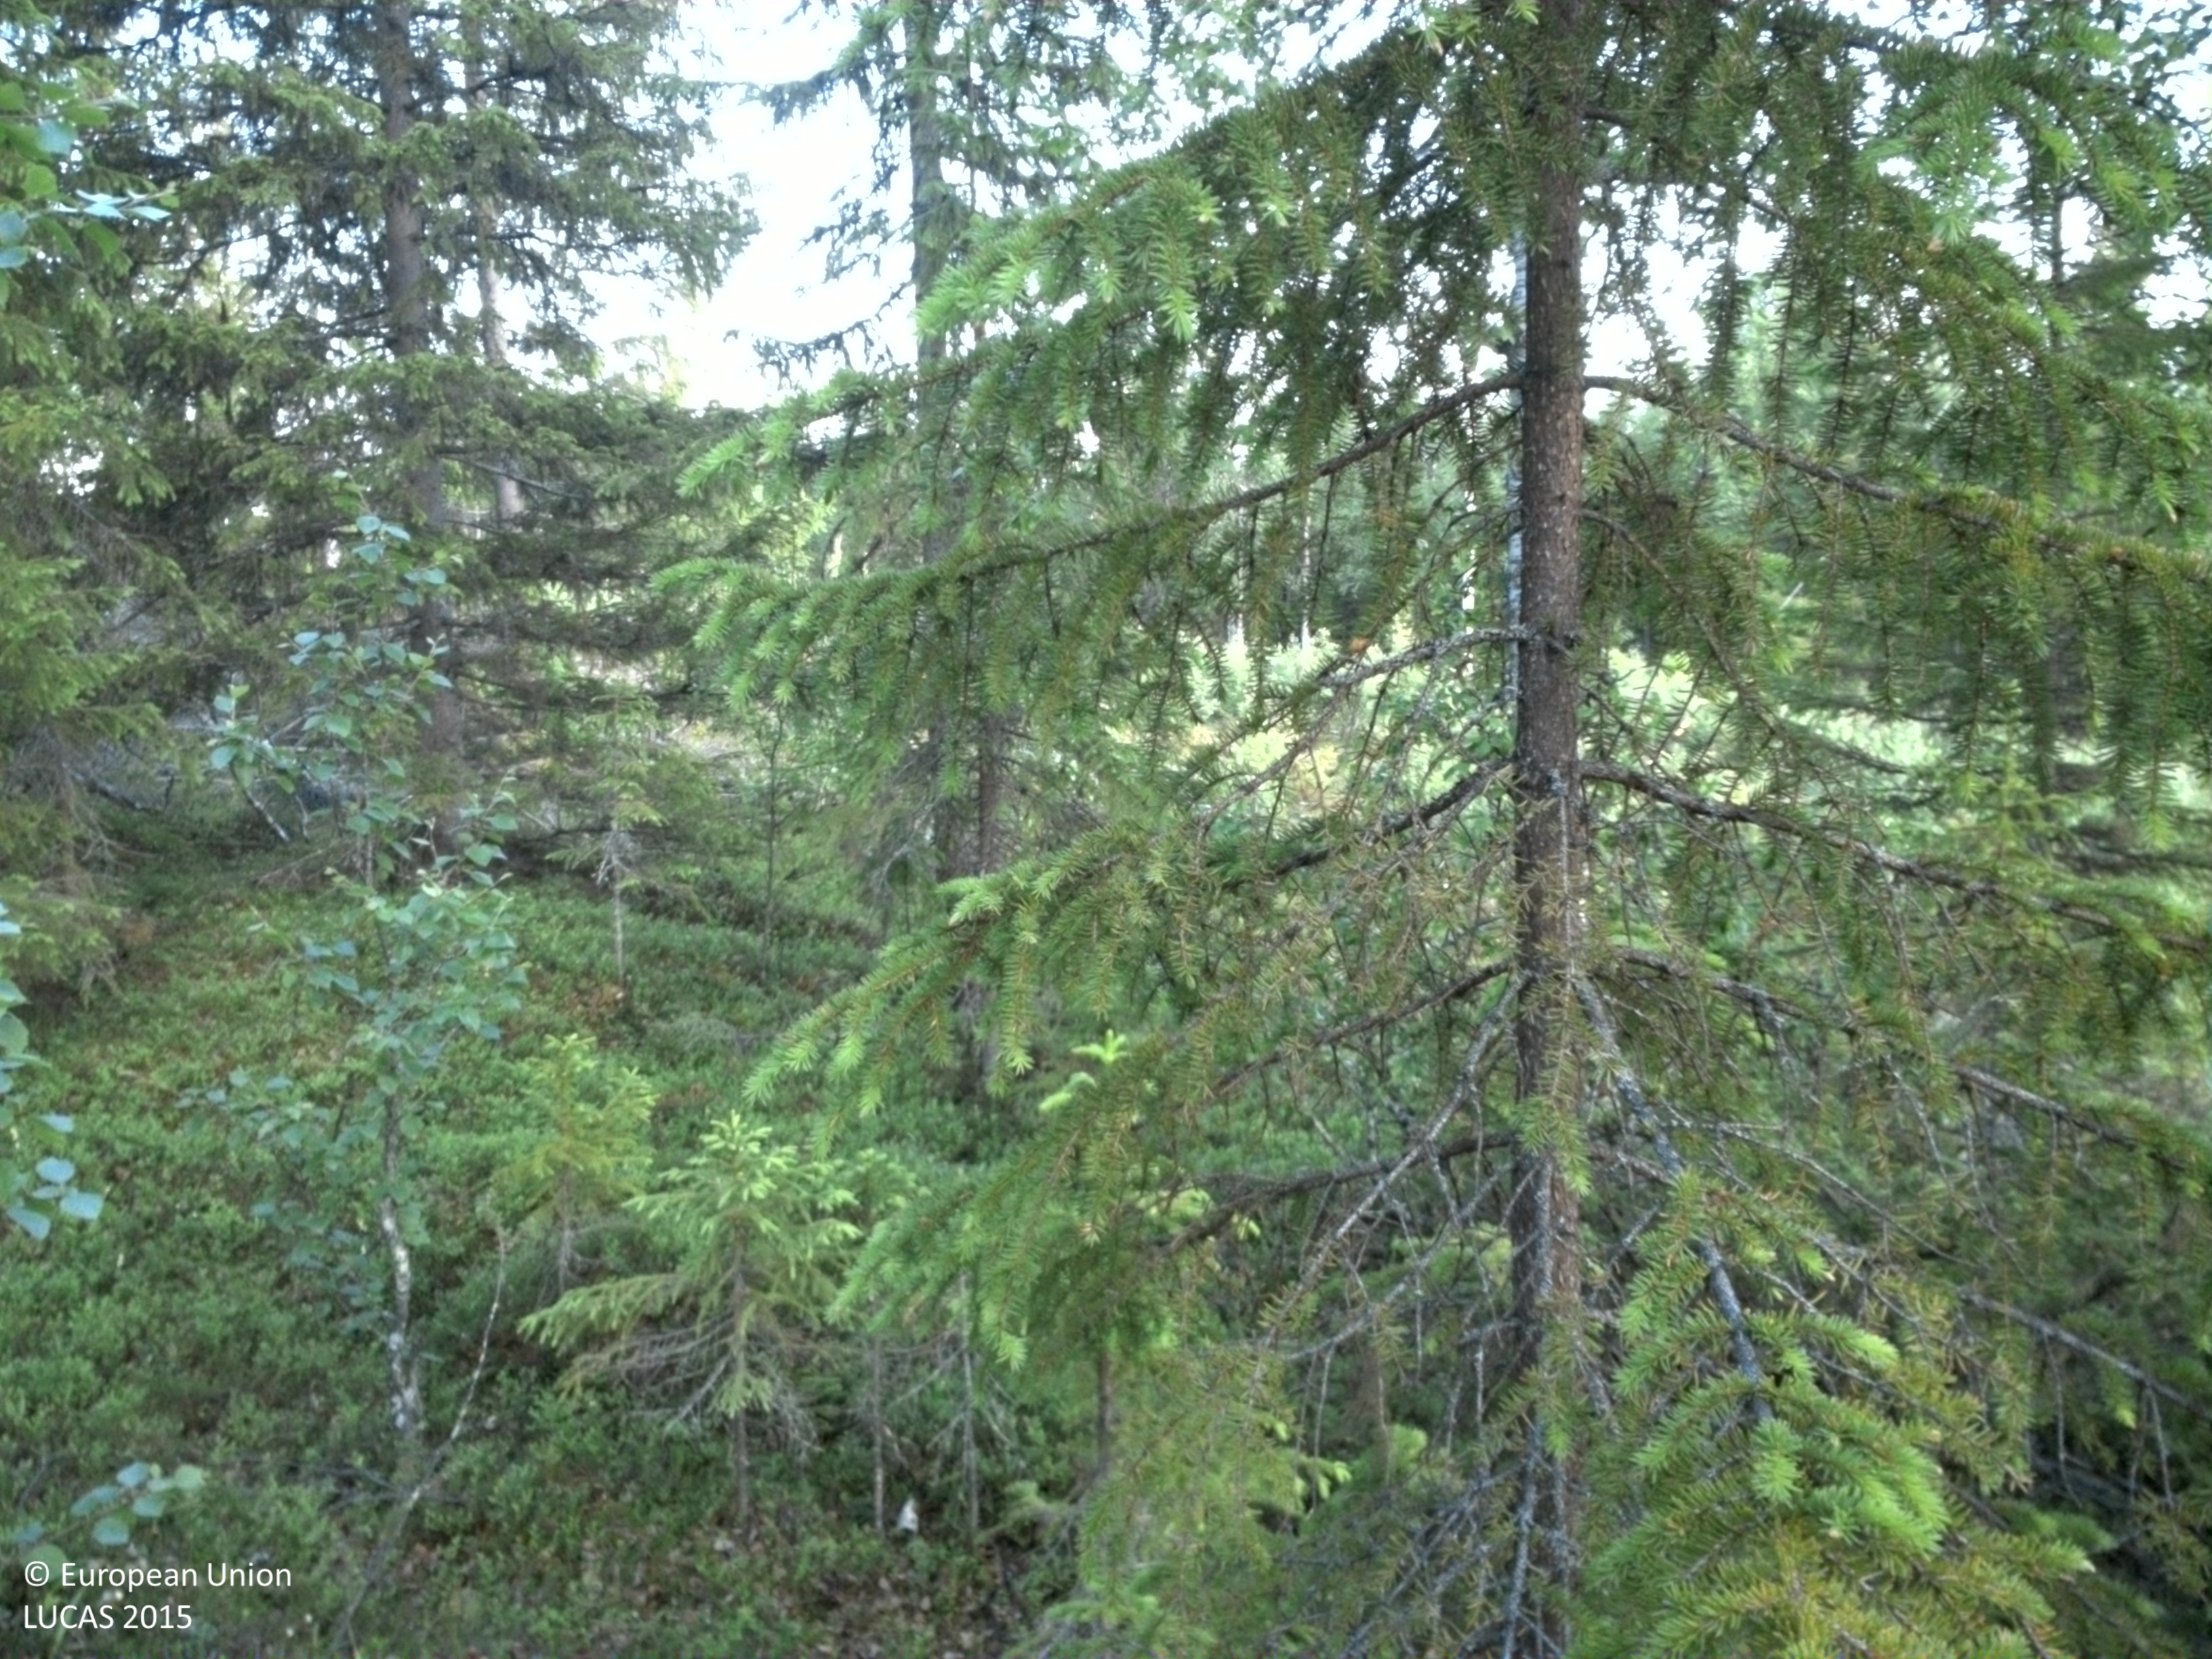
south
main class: Woodland
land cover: Spruce dominated mixed woodland
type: boreal forest
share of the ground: 25 - 50 %
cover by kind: shrubs 45 %, coniferous forest trees 25 %, broadleaved forest trees 20 %, lichens and mosses 10 %
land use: Forestry
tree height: > 5 m
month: July
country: SE
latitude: 65.5365
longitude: 15.4400
